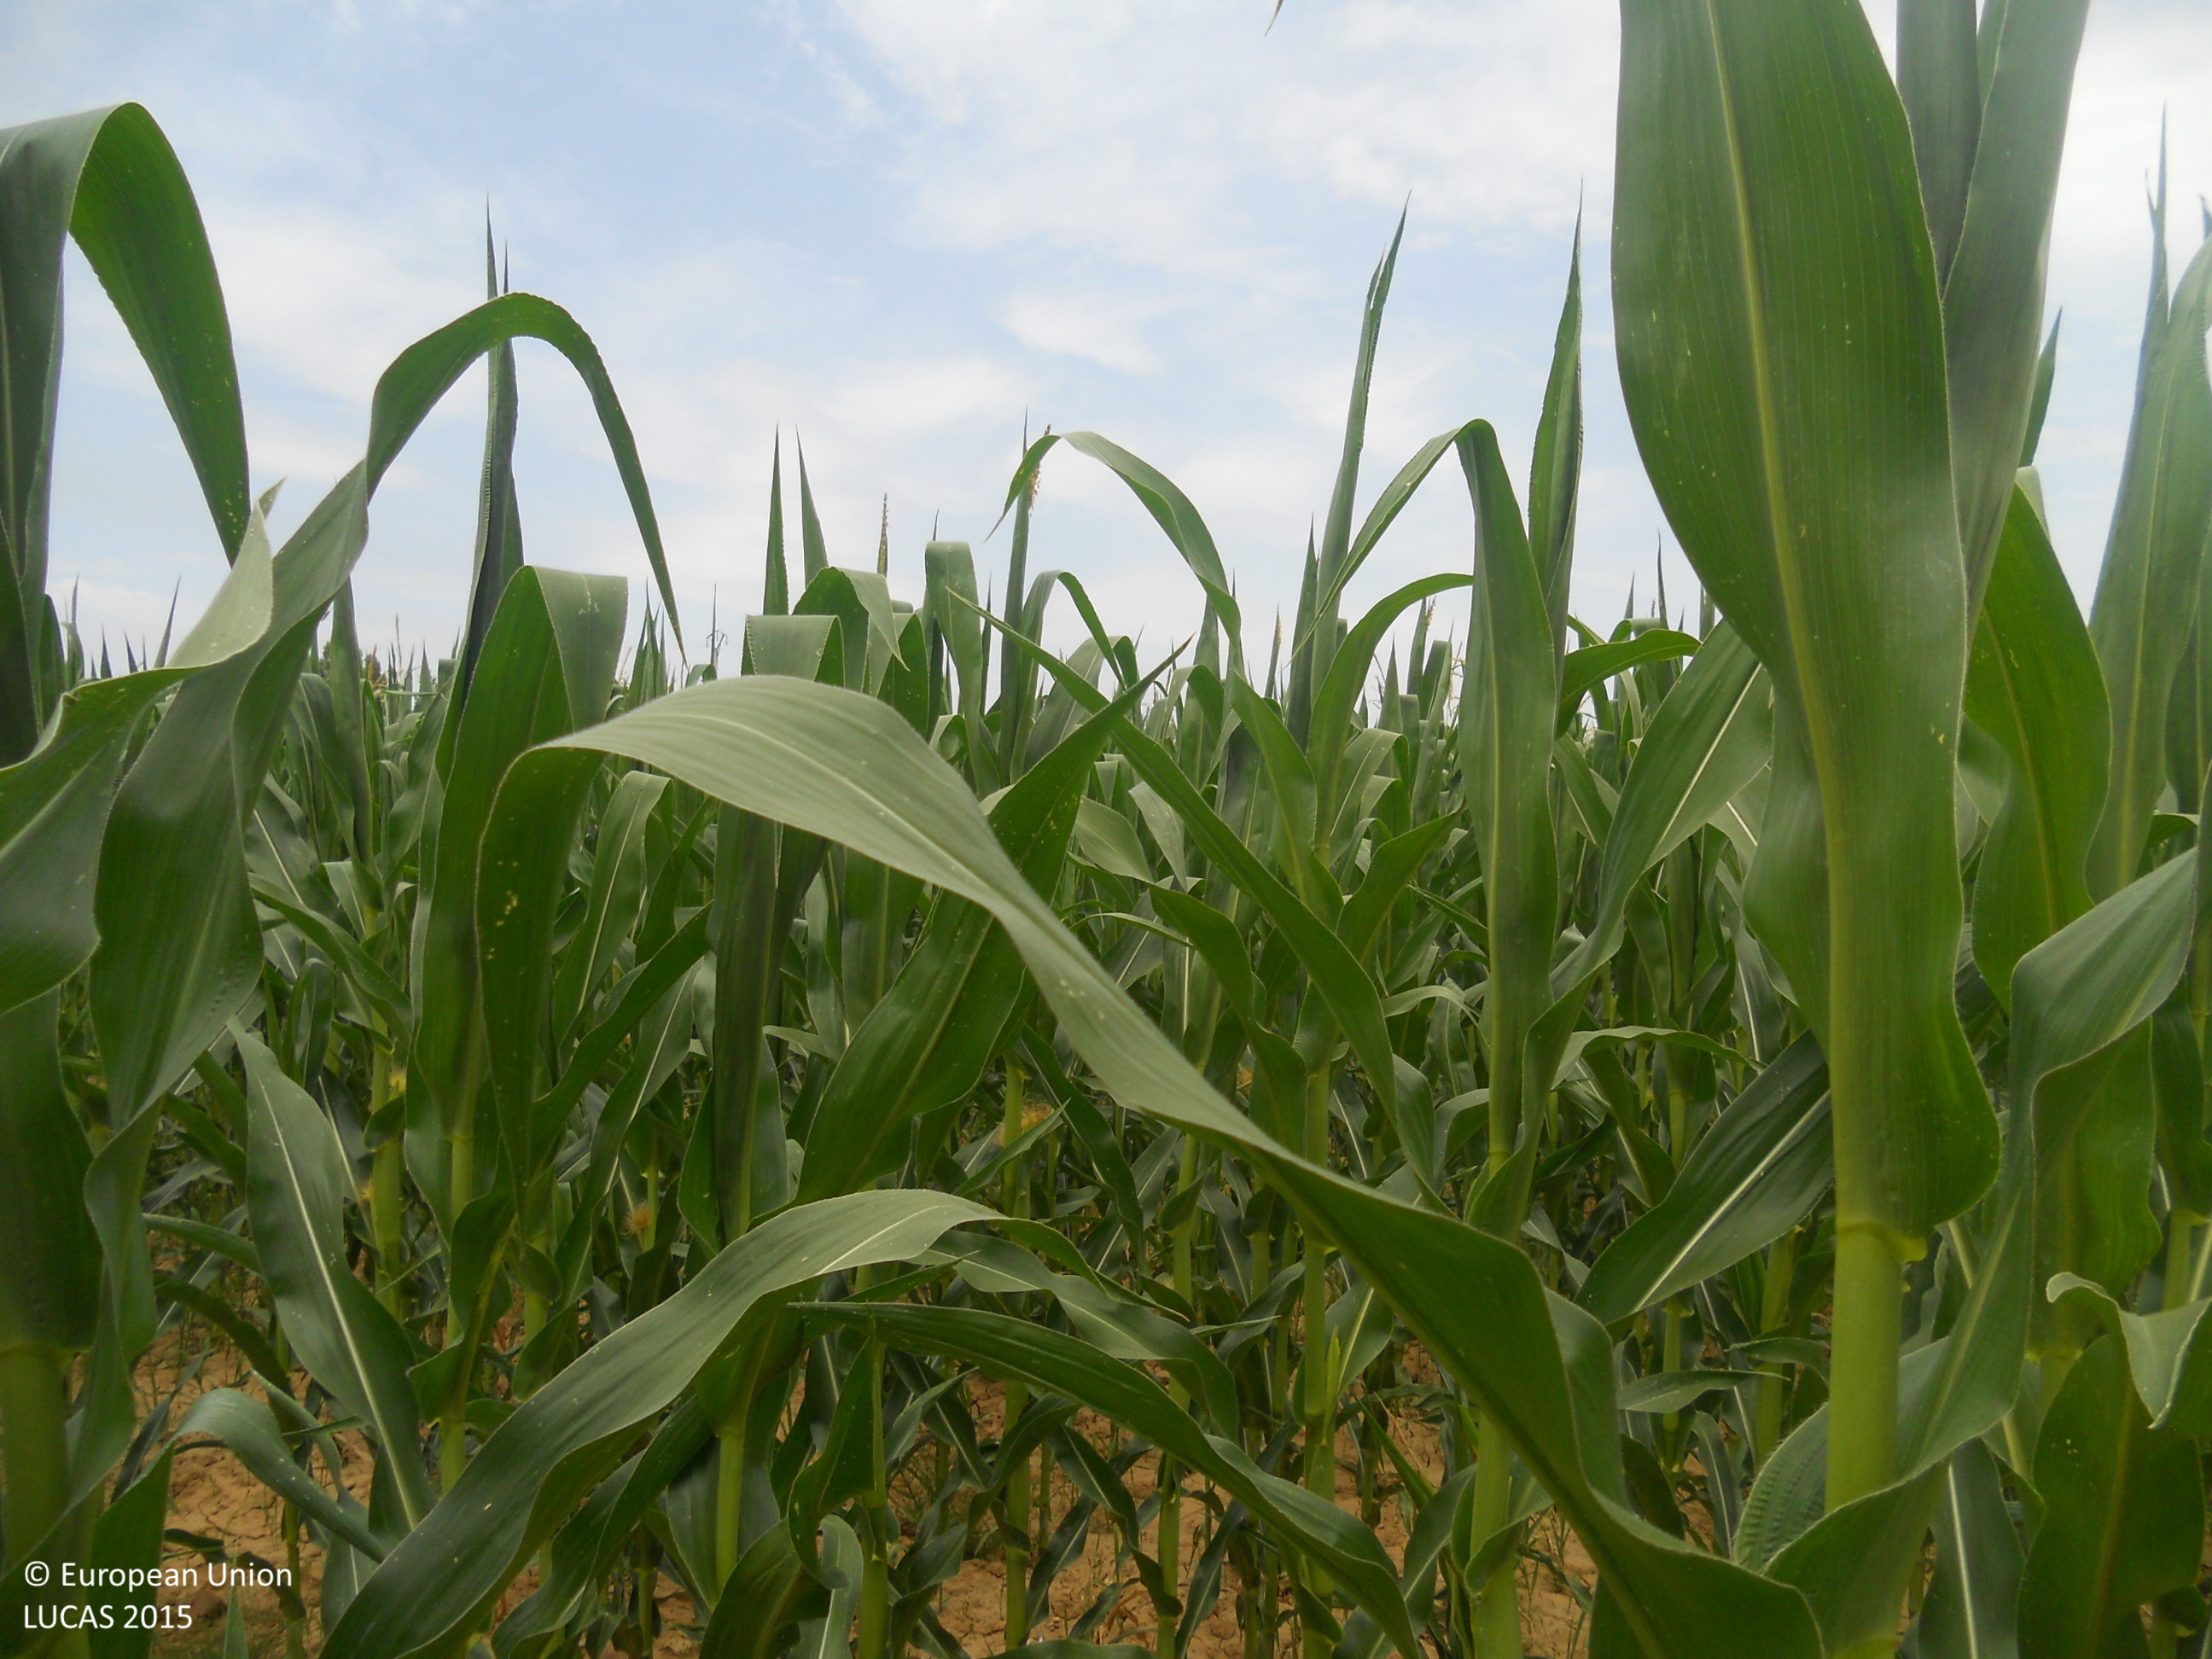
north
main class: Cropland
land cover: Maize
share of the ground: > 75 %
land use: Agriculture (excluding fallow land and kitchen gardens)
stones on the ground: < 10 %
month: July
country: ES
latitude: 42.5469
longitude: -5.4251
